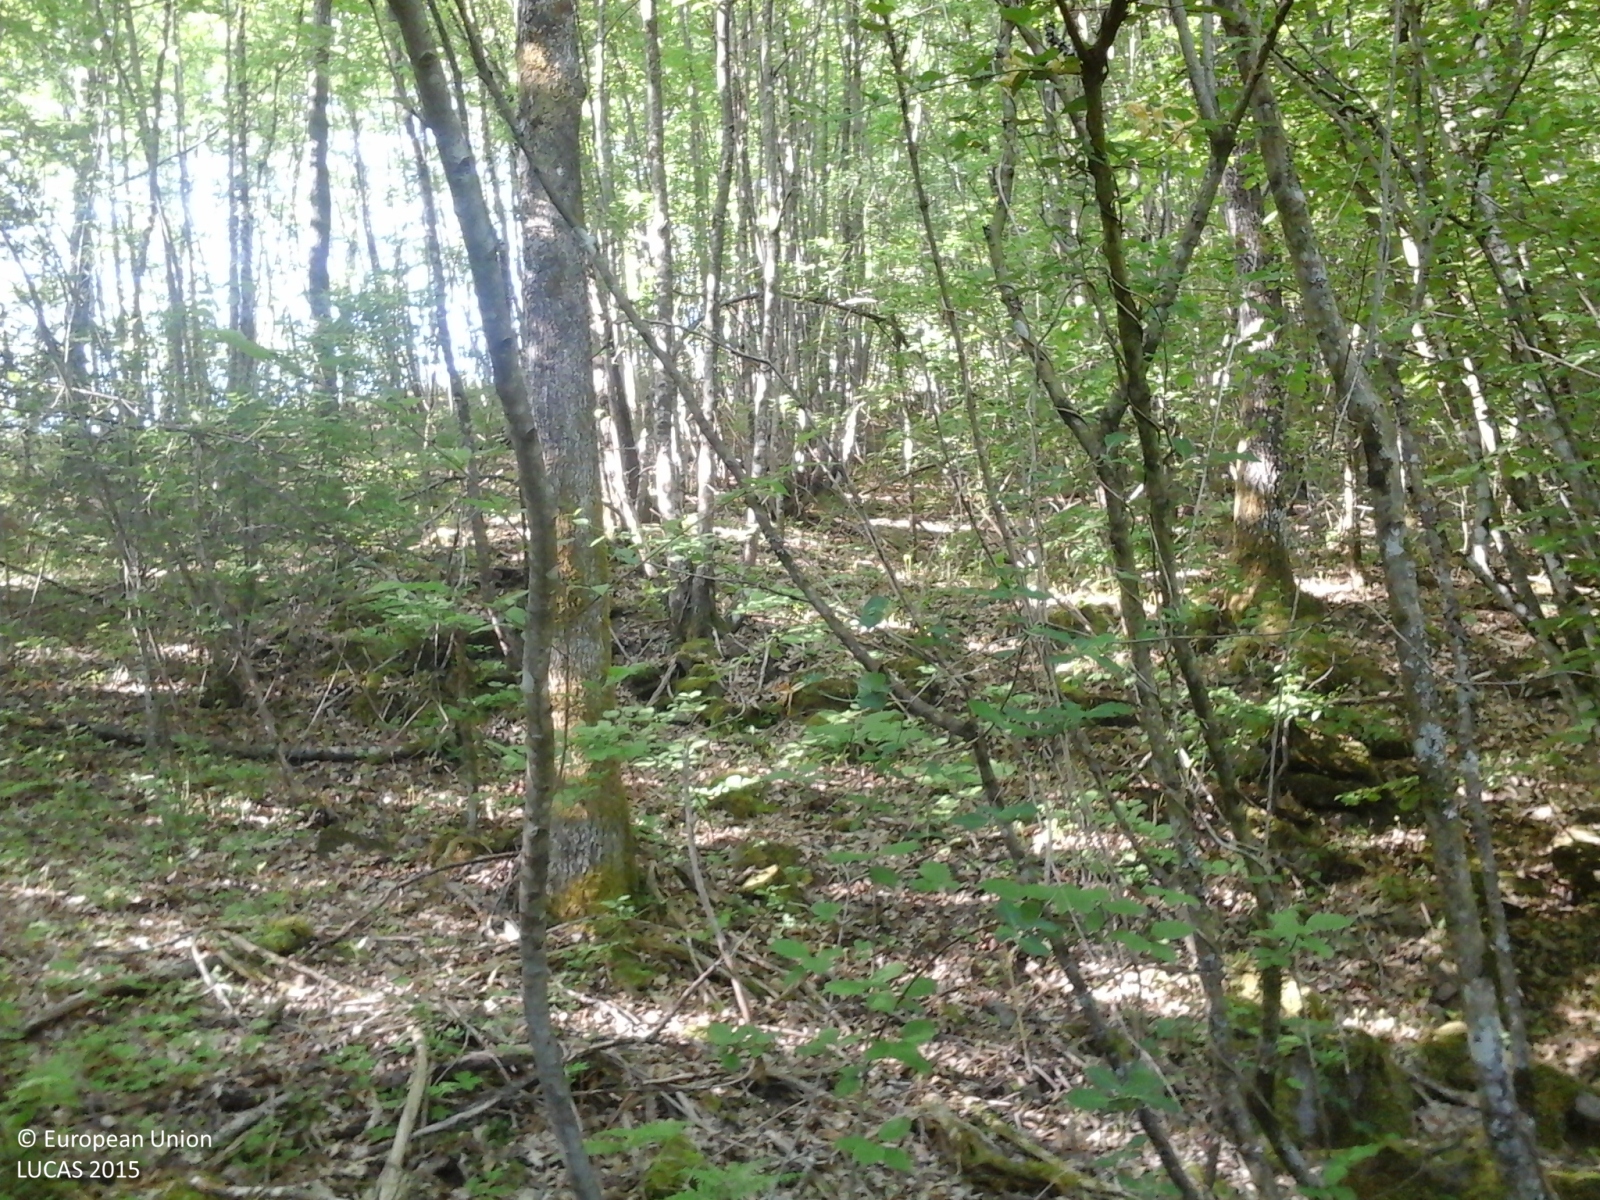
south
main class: Woodland
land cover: Broadleaved woodland
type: thermophilous deciduous forest
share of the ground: > 75 %
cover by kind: broadleaved forest trees 90 %, shrubs 10 %
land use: Forestry
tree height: > 5 m
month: May
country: IT
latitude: 44.5304
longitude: 9.6861
